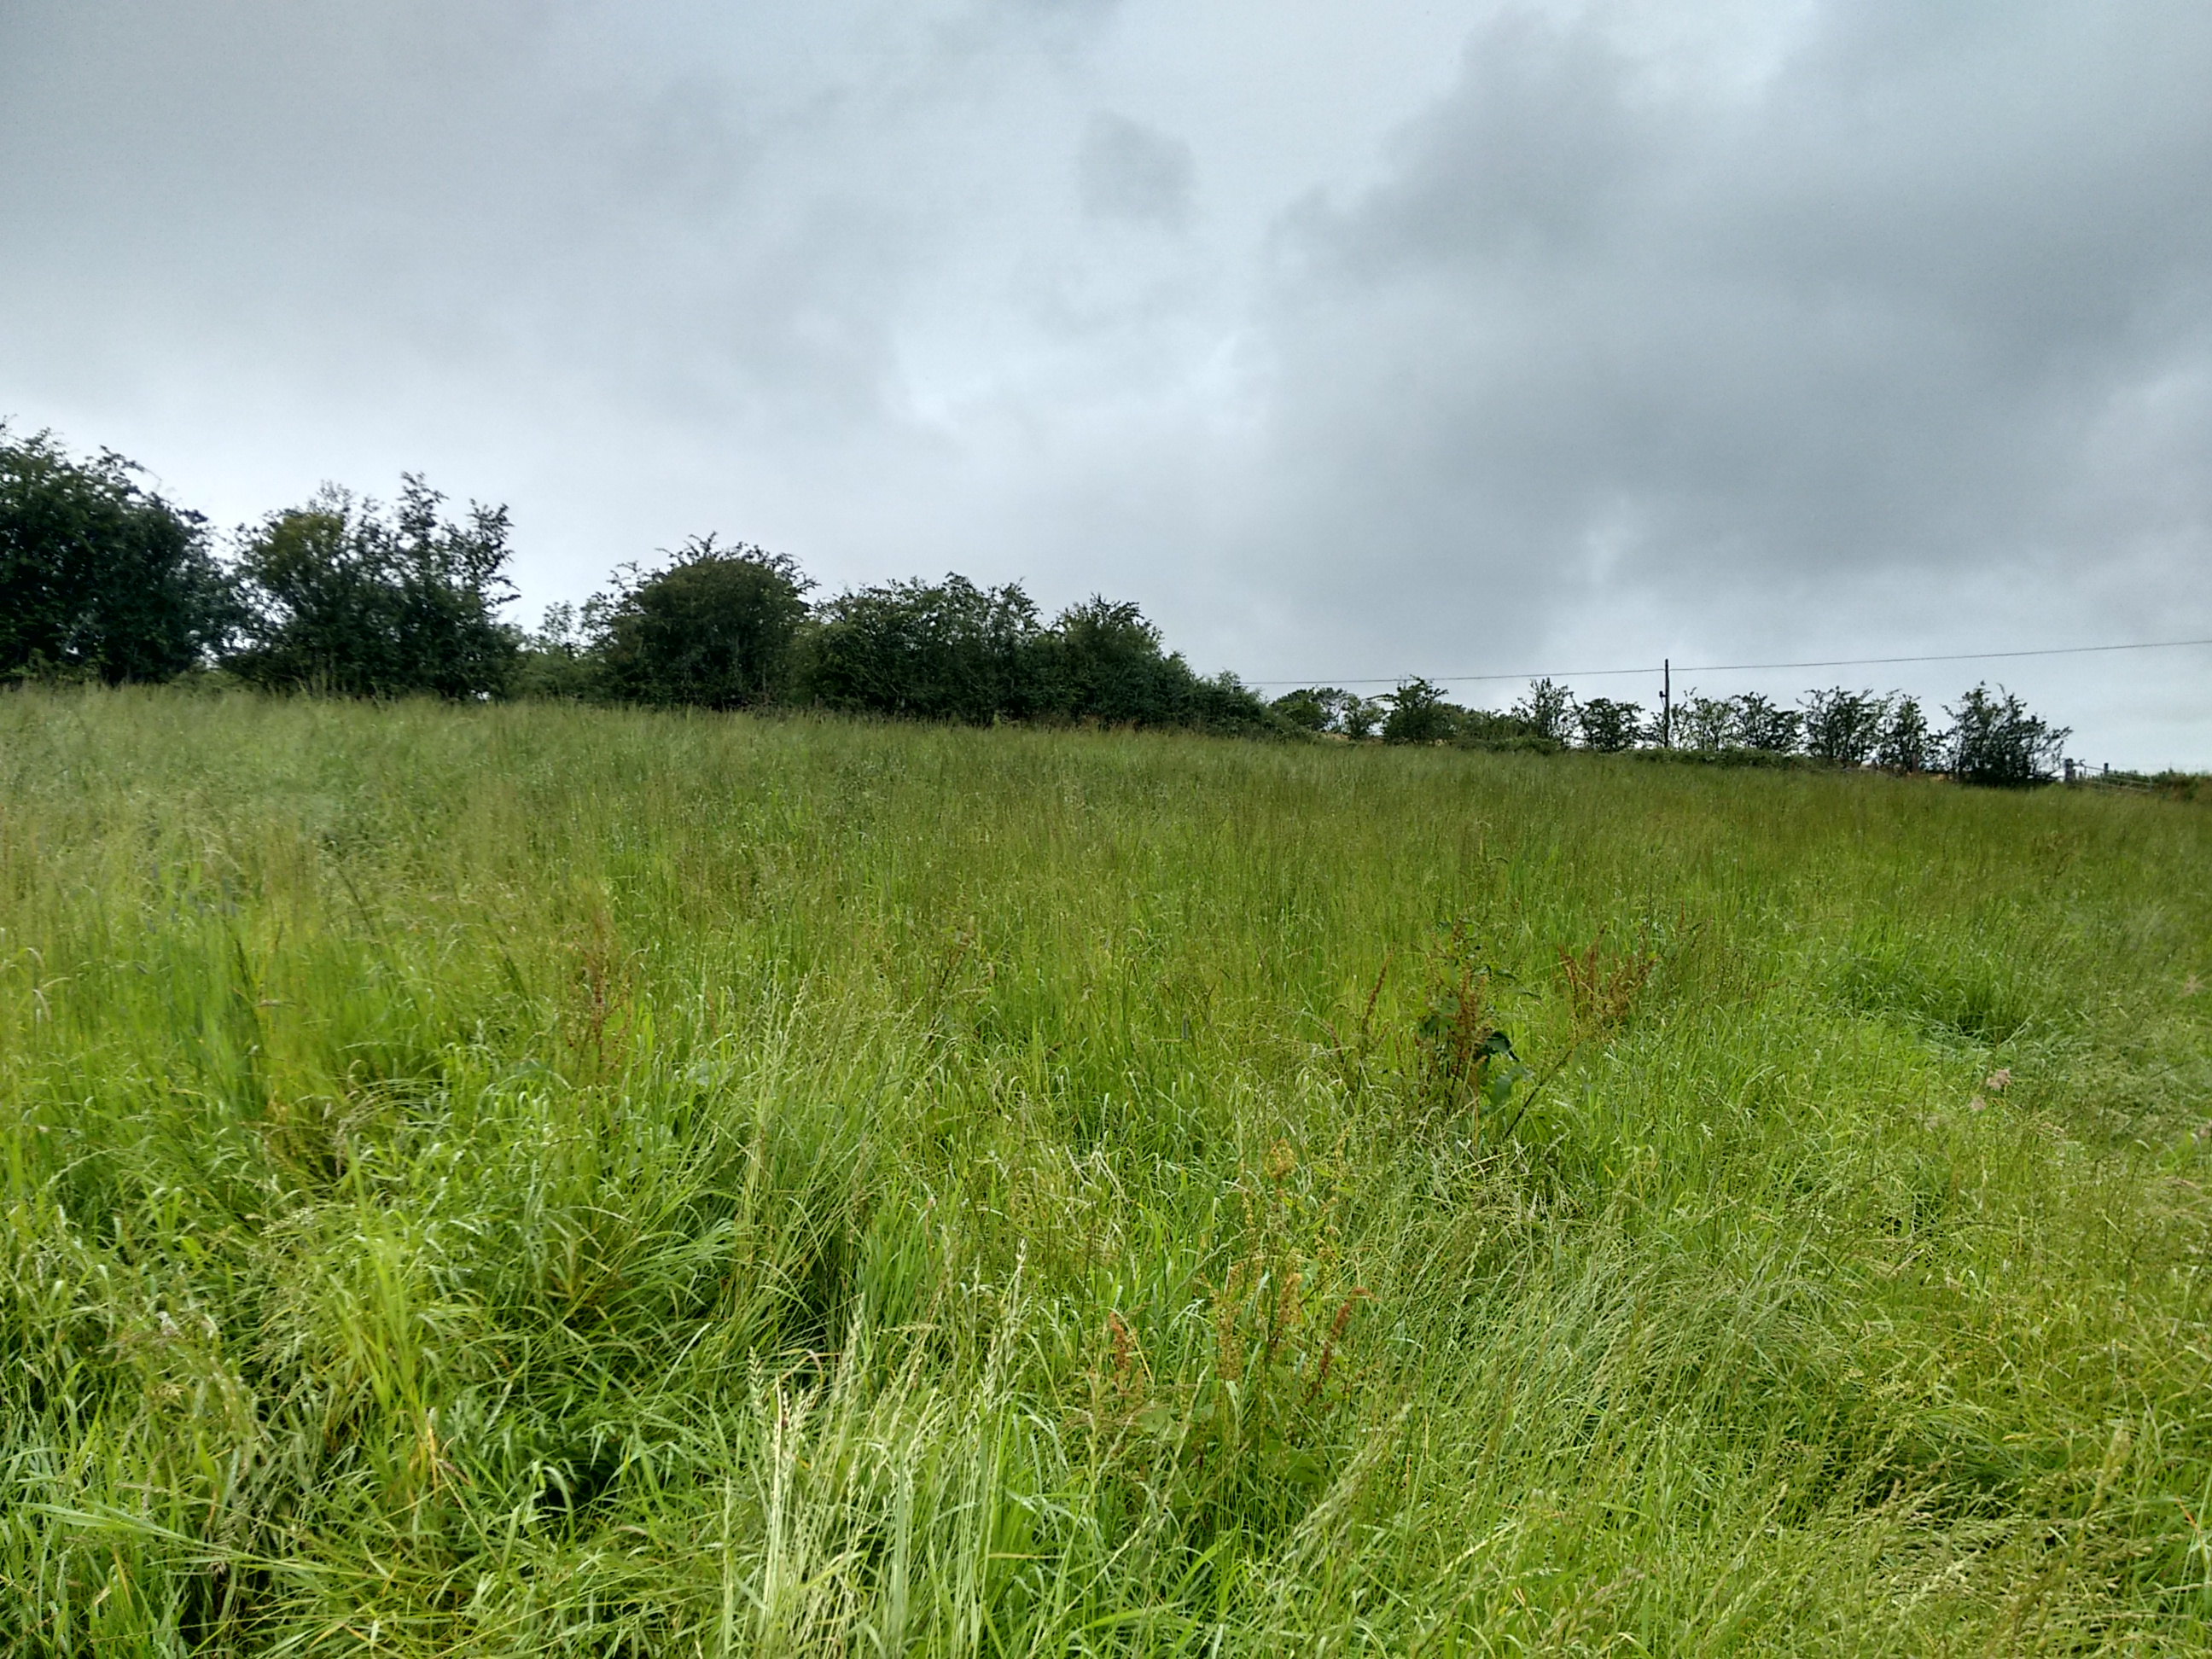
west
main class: Grassland
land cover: Grassland without tree/shrub cover
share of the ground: > 75 %
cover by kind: herbaceous plants 100 %
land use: Agriculture (excluding fallow land and kitchen gardens)
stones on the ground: 25 - 50 %
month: August
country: GB
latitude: 54.5195
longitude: -6.7707
